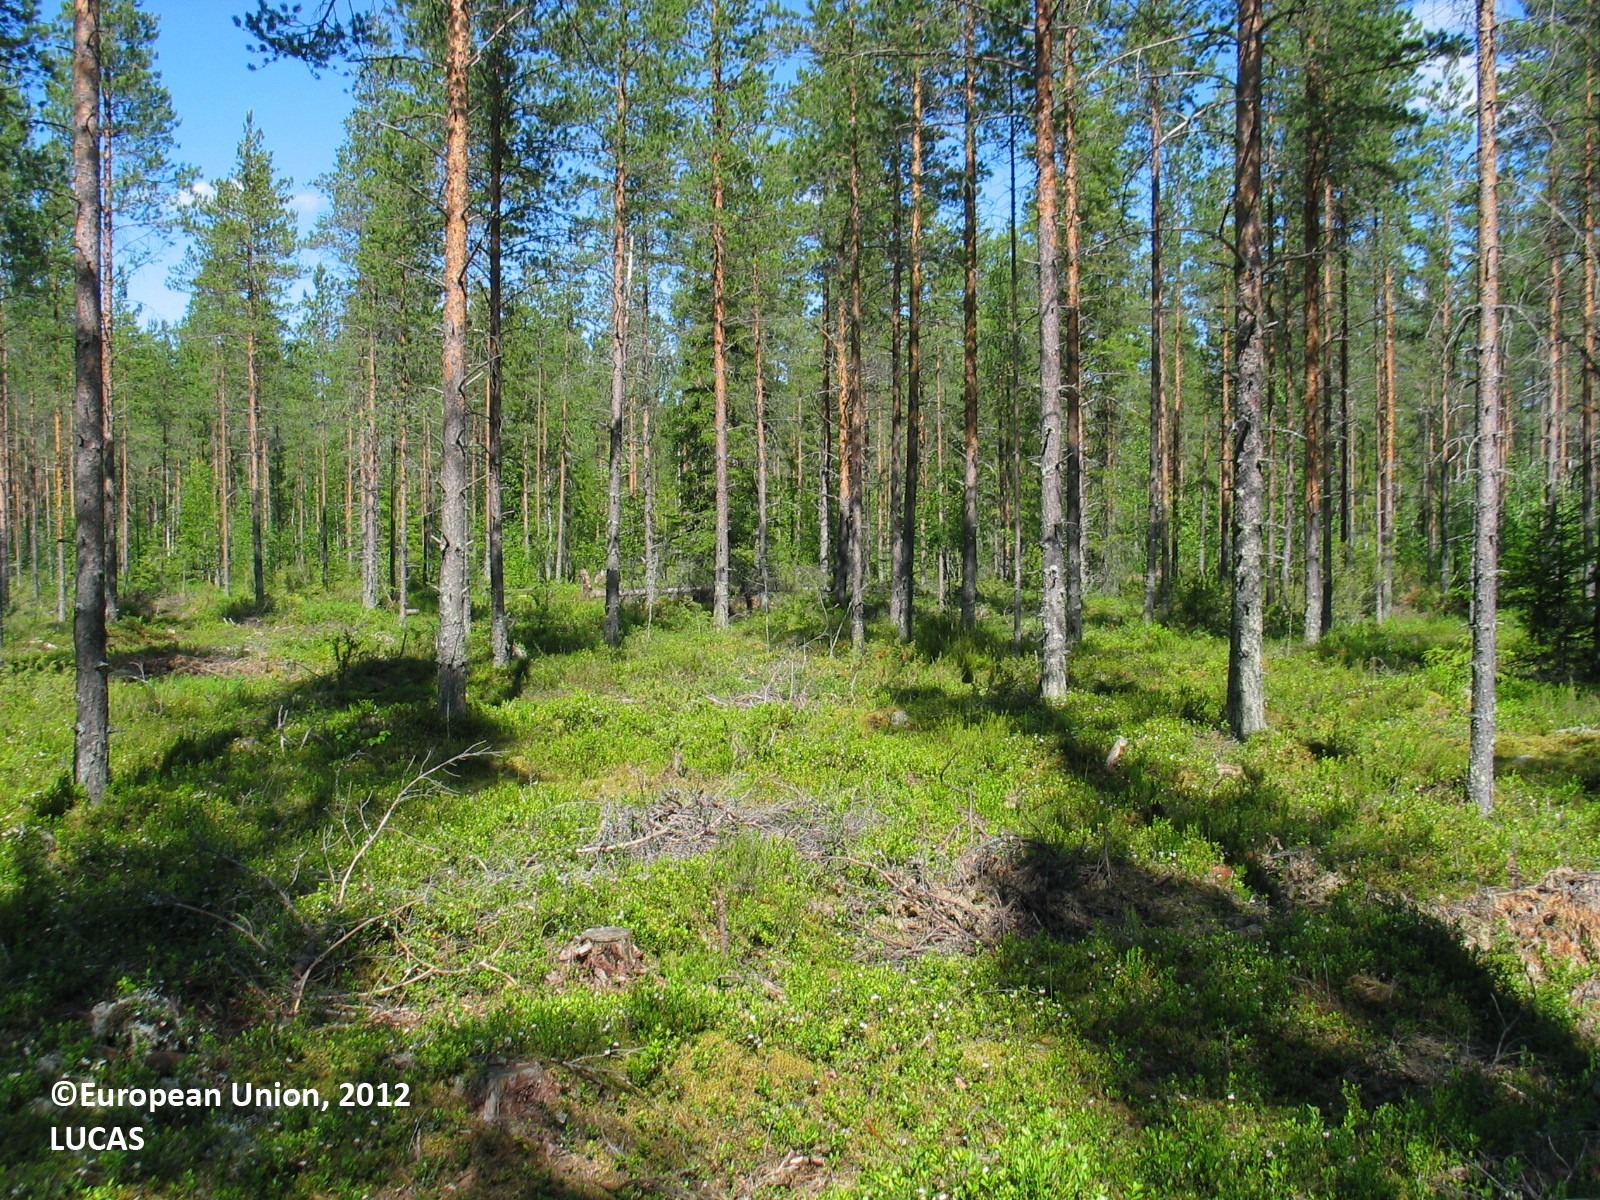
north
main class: Woodland
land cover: Pine dominated coniferous woodland
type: boreal forest
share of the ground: 25 - 50 %
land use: Forestry
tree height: > 5 m
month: July
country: FI
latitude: 64.7299
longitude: 26.5089
